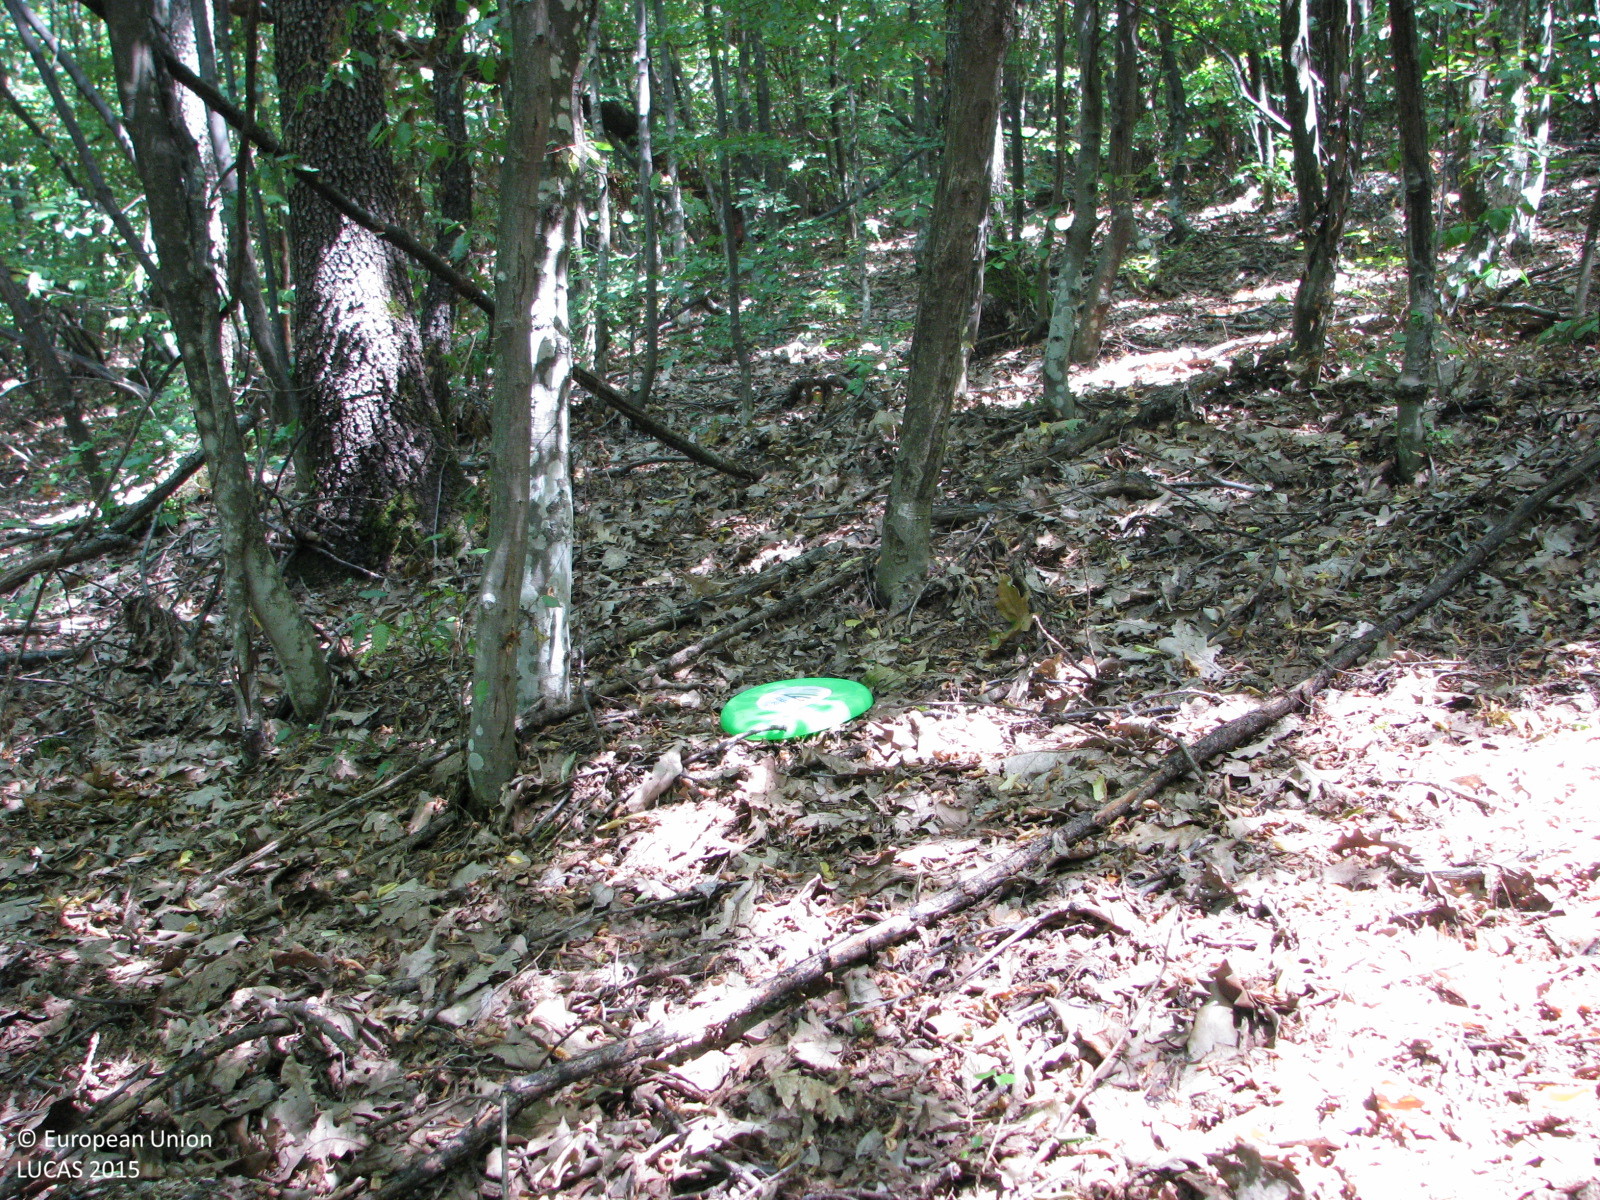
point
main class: Woodland
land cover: Broadleaved woodland
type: beech forest
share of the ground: > 75 %
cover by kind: broadleaved forest trees 85 %, unconsolidated bare surface 15 %
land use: Forestry
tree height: > 5 m
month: August
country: BG
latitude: 42.7582
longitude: 26.1804
